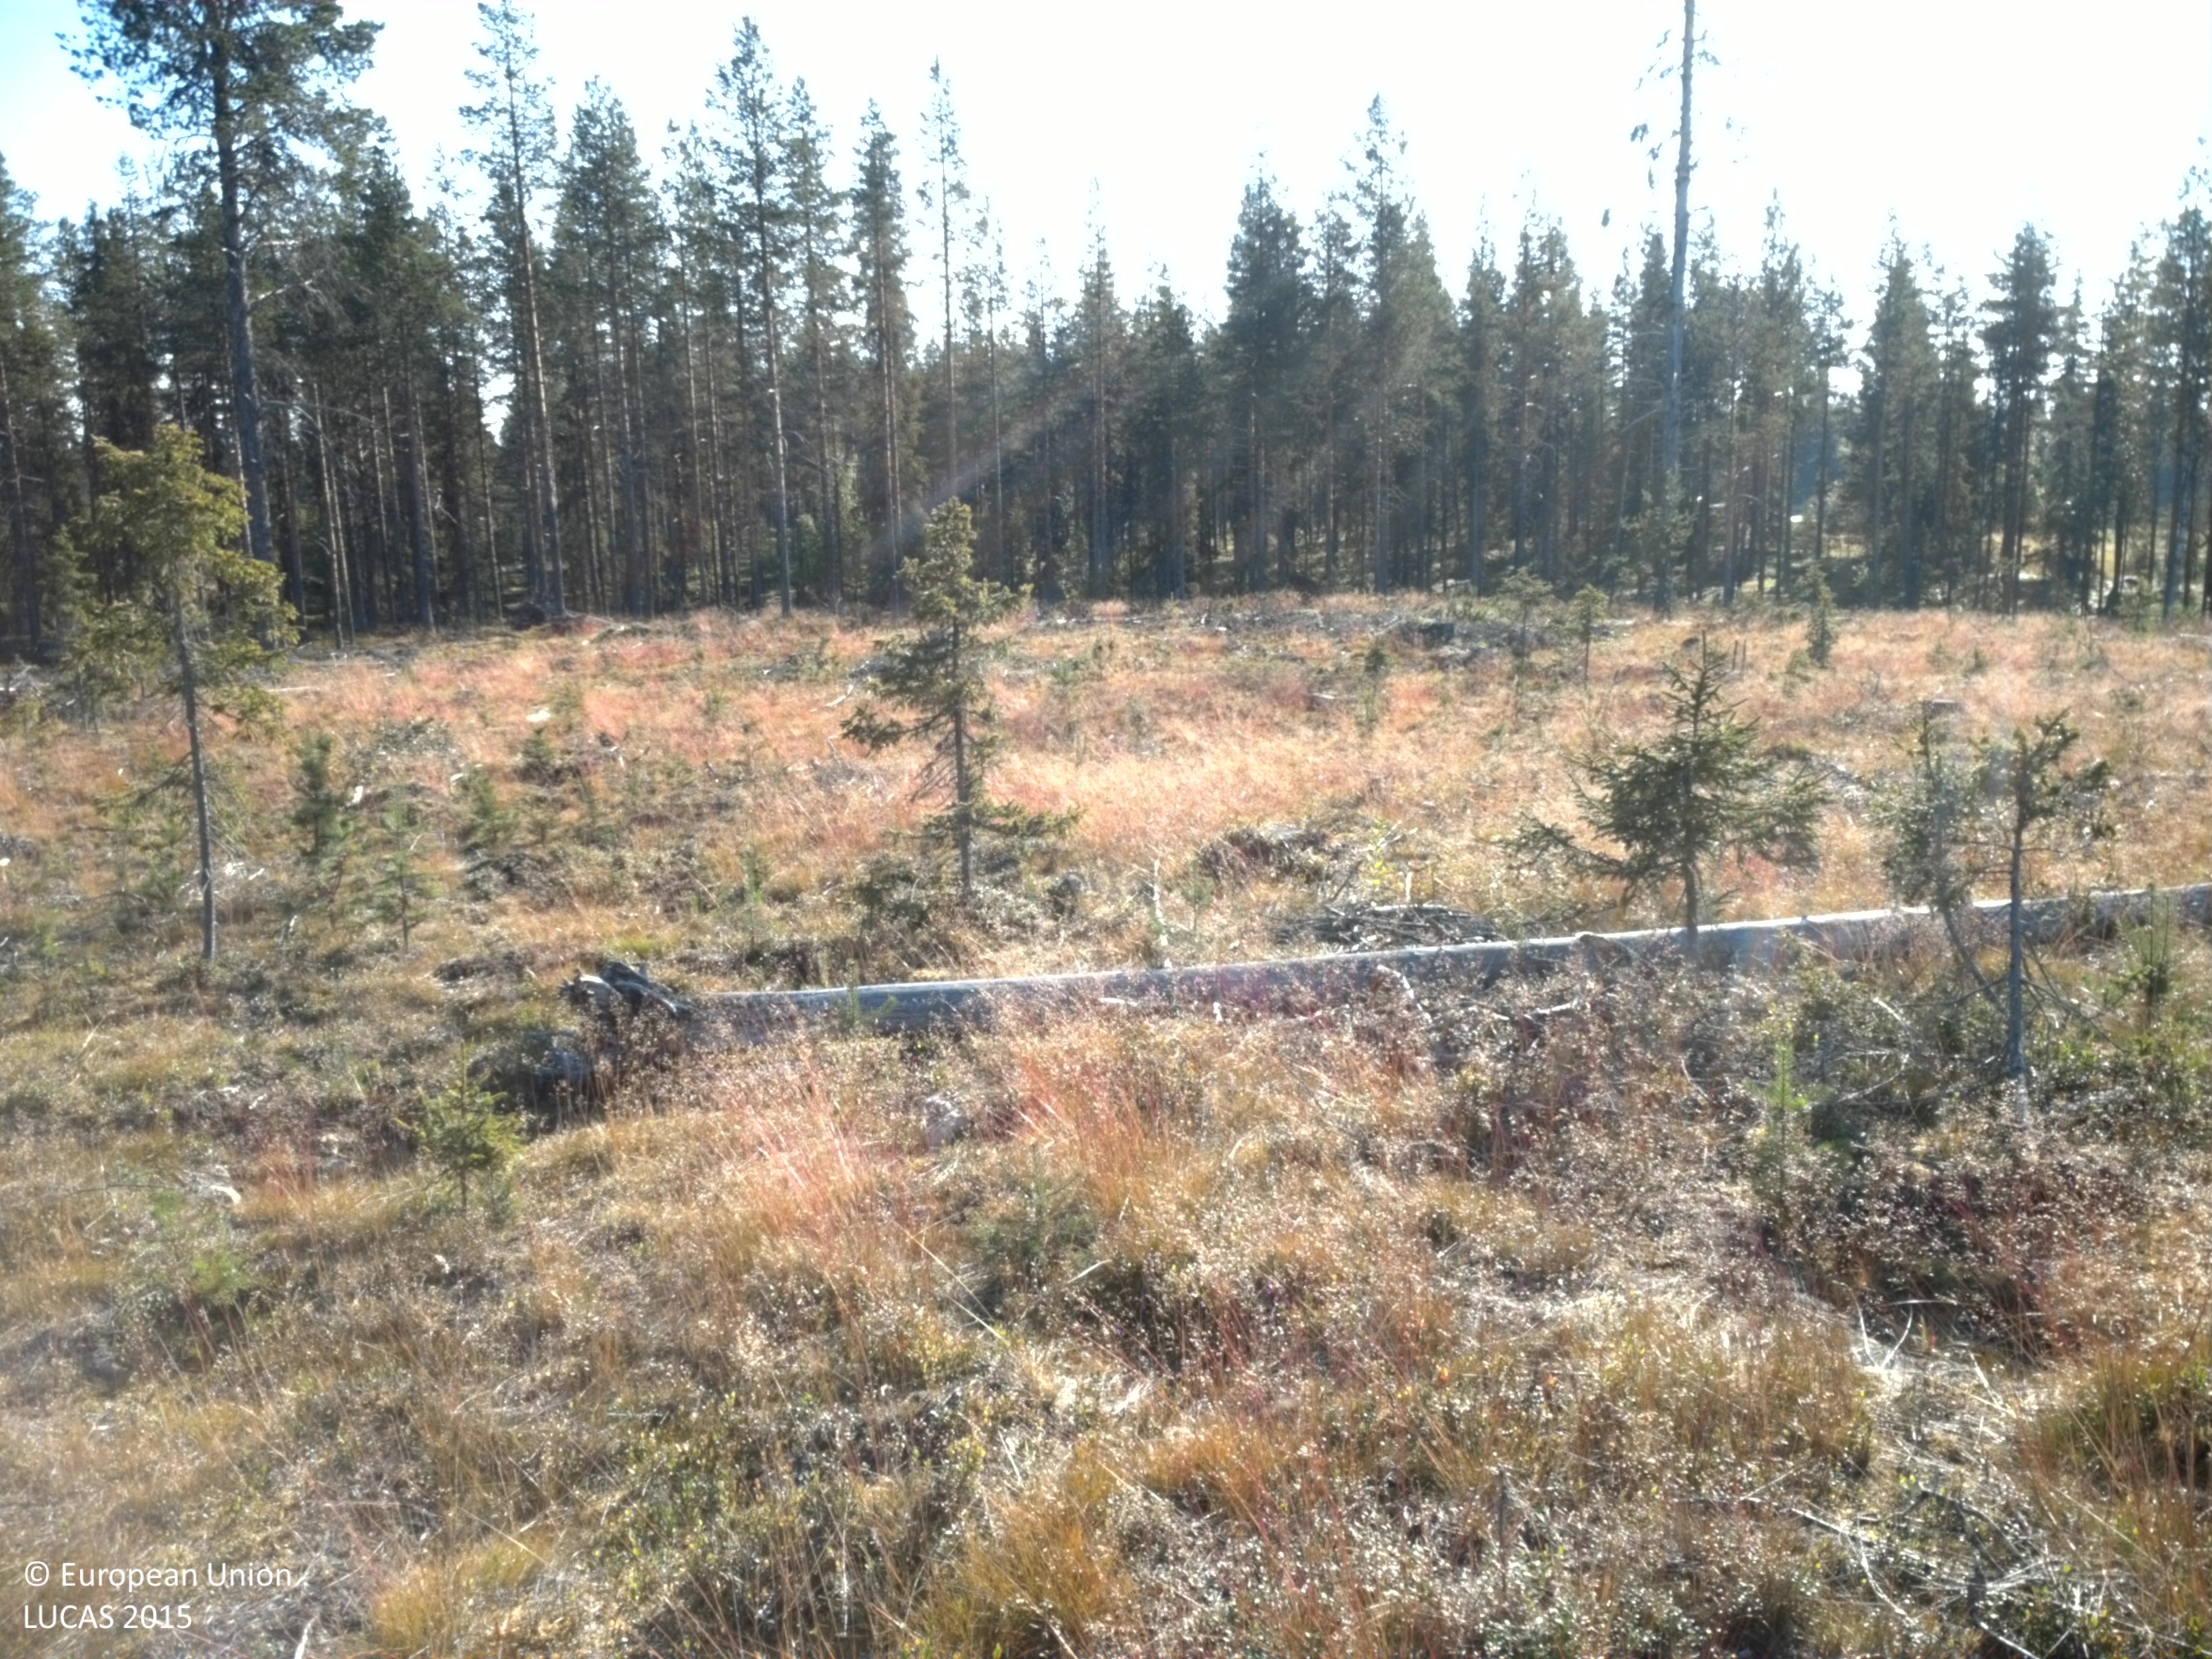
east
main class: Grassland
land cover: Grassland with sparse tree/shrub cover
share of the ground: > 75 %
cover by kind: herbaceous plants 85 %, coniferous forest trees 5 %, shrubs 5 %, consolidated bare surface 5 %
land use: Forestry
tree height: < 5 m
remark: Clear cut
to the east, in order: Grassland with sparse tree/shrub cover; Pine dominated coniferous woodland; Tracks; Pine dominated coniferous woodland
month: August
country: SE
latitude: 66.8346
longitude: 20.9575
